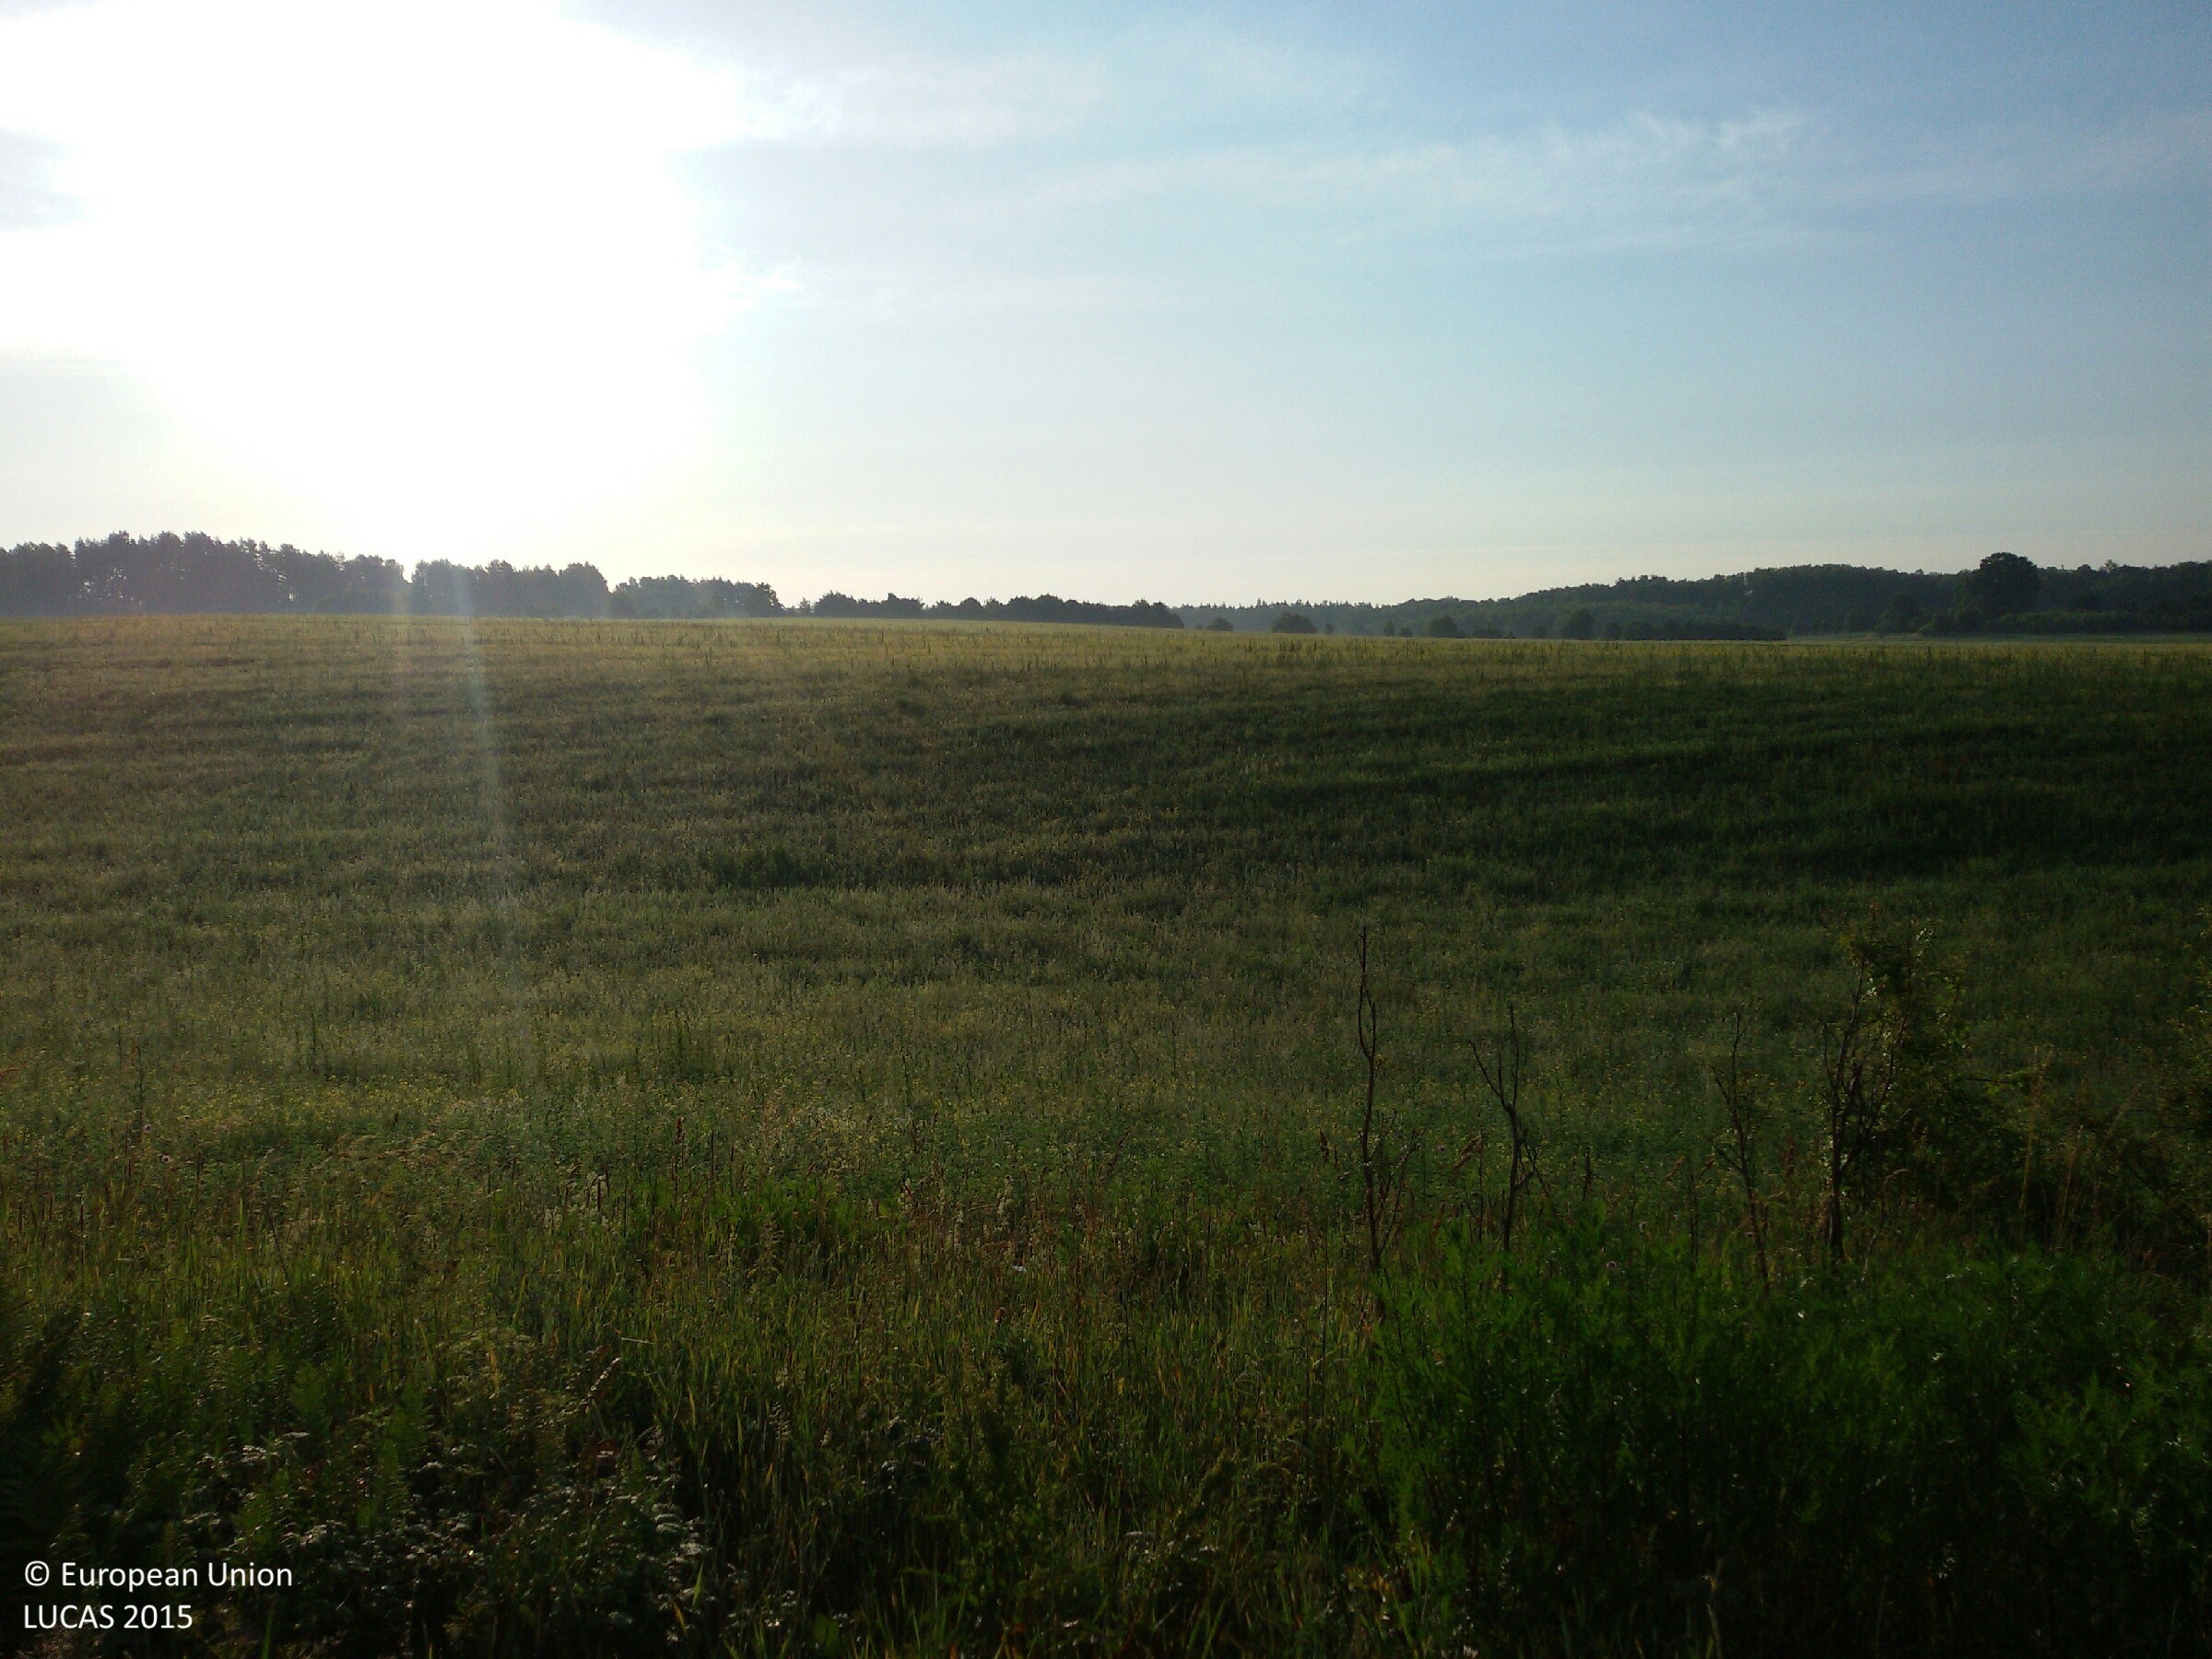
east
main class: Grassland
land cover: Grassland without tree/shrub cover
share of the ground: > 75 %
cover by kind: herbaceous plants 95 %, unconsolidated bare surface 5 %
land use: Air transport
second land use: Agriculture (excluding fallow land and kitchen gardens)
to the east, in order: Grassland without tree/shrub cover; Tracks; Grassland with sparse tree/shrub cover; Rape and turnip rape
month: June
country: PL
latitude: 53.5356
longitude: 20.1575
